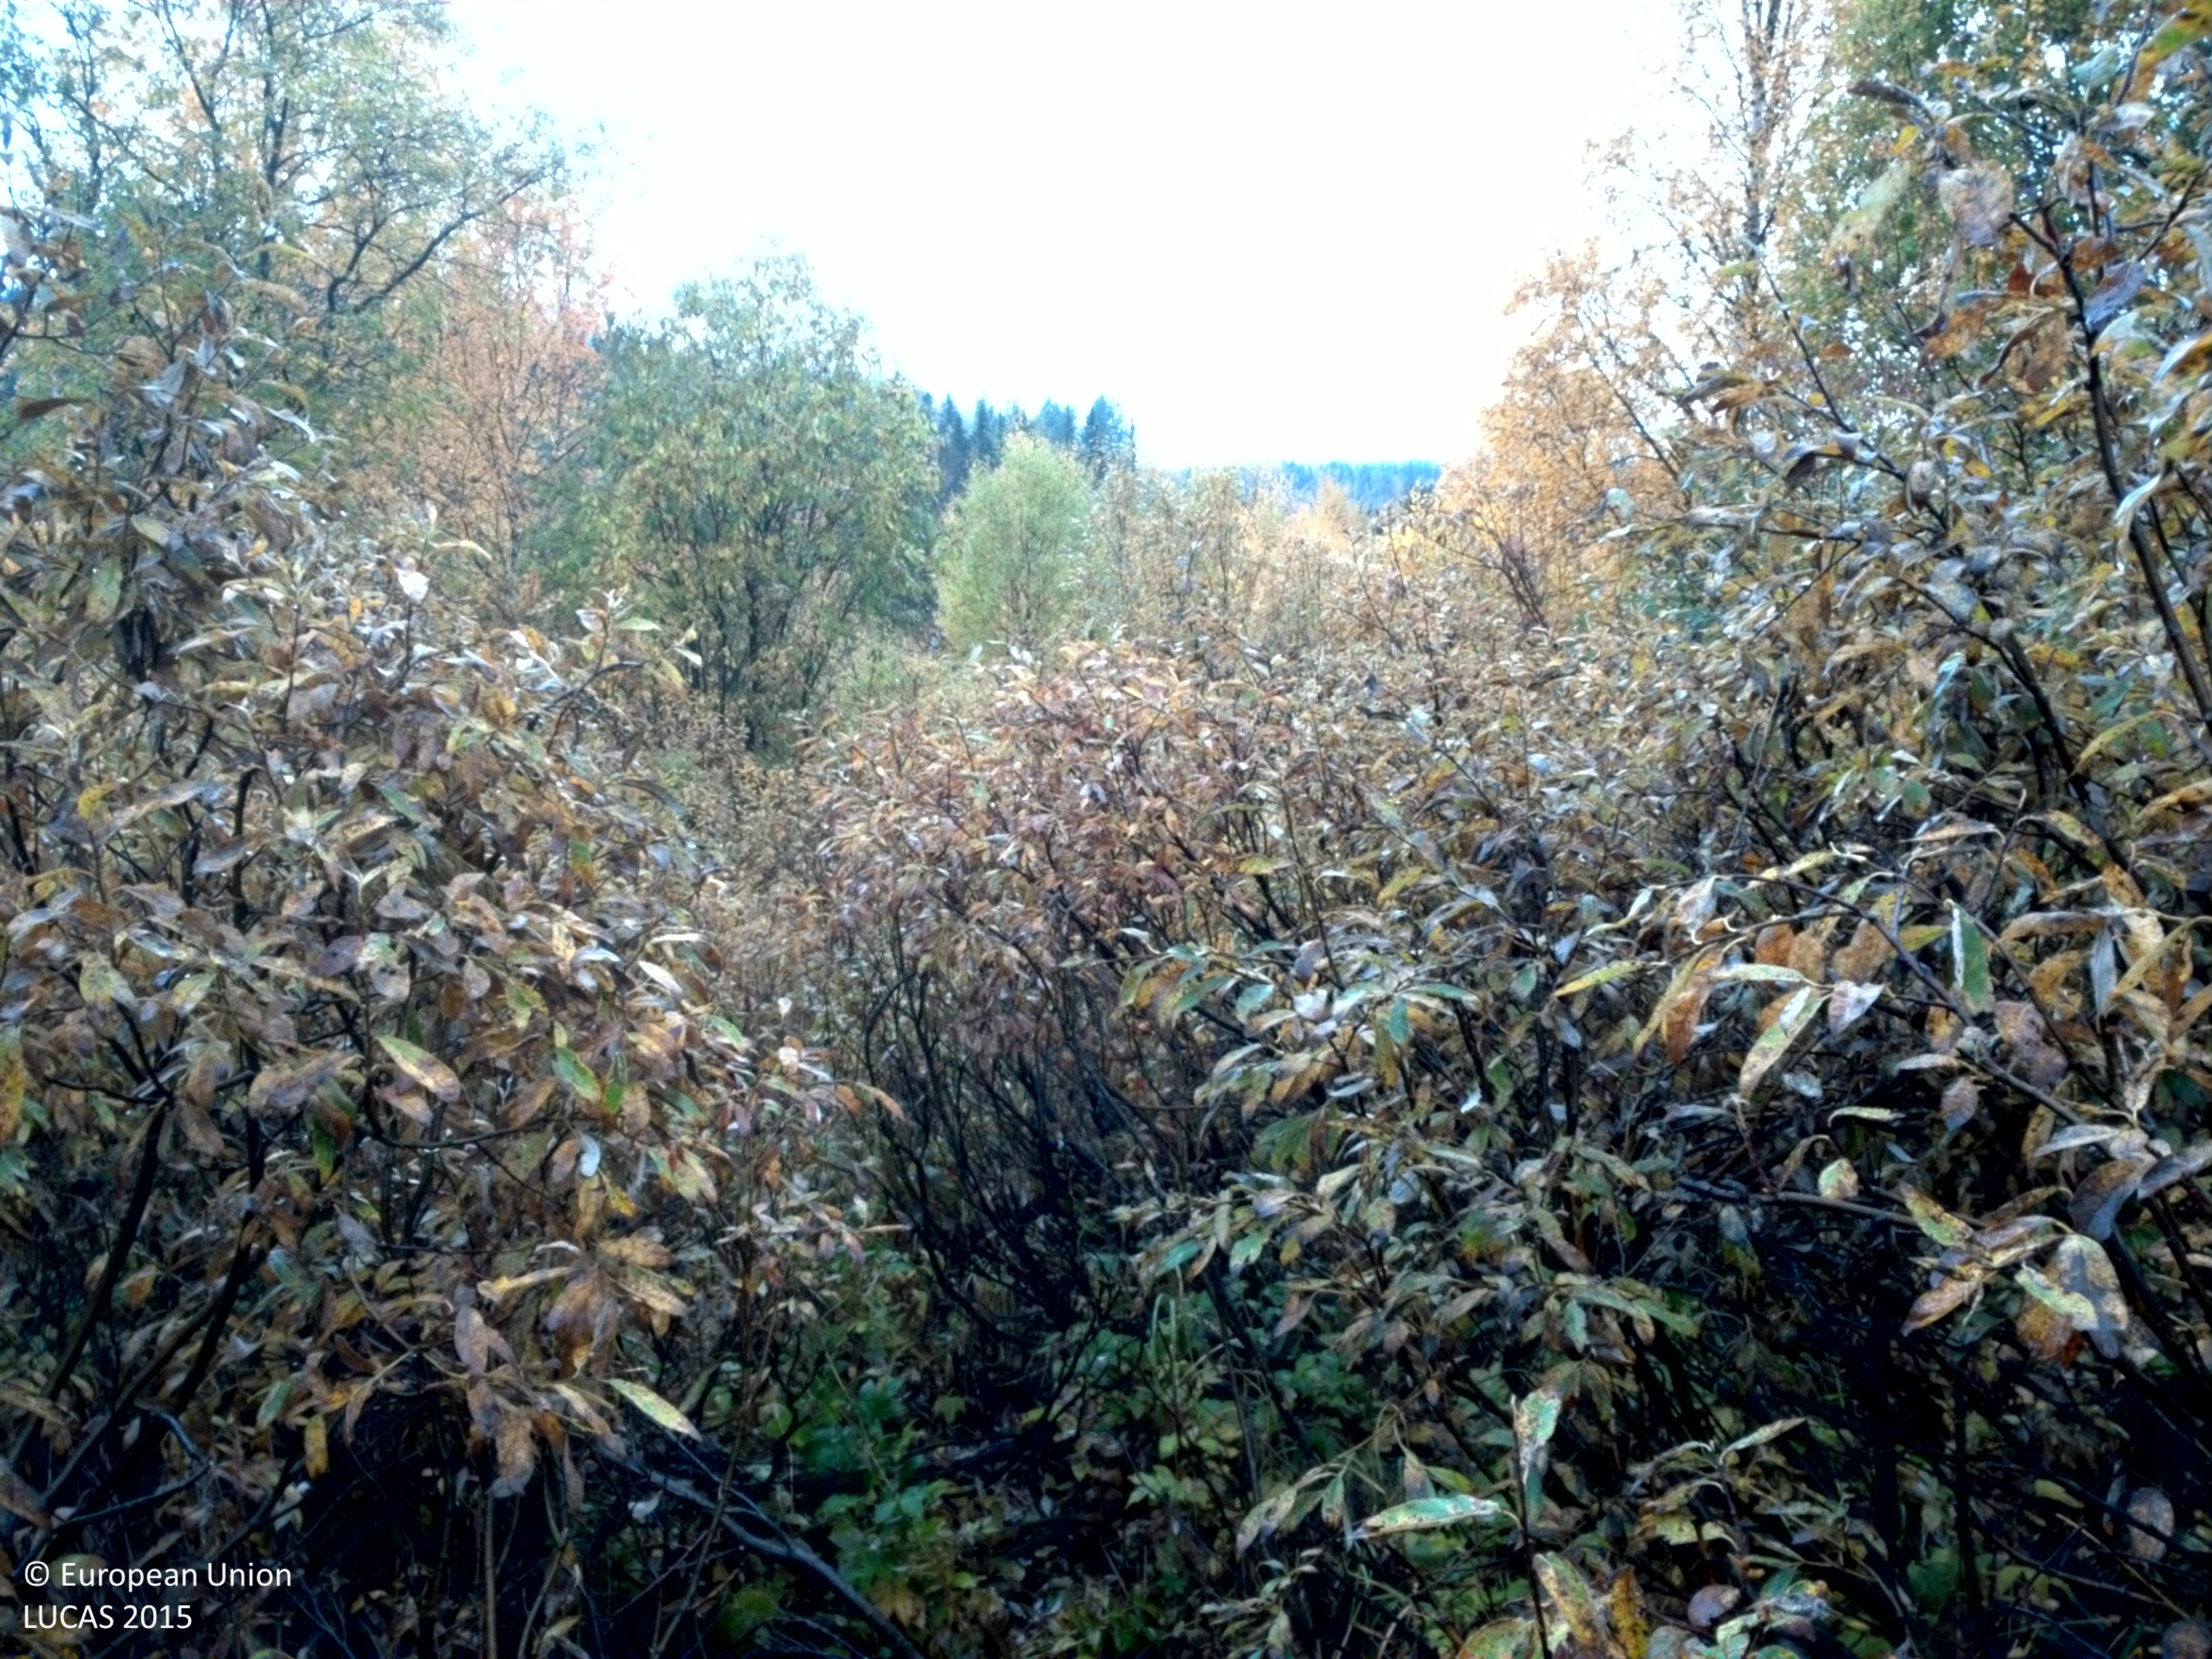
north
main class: Shrubland
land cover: Shrubland with sparse tree cover
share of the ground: > 75 %
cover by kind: shrubs 85 %, herbaceous plants 10 %, broadleaved forest trees 5 %
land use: Semi-natural and natural areas not in use
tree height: > 5 m
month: September
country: SE
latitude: 65.3099
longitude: 16.2070
